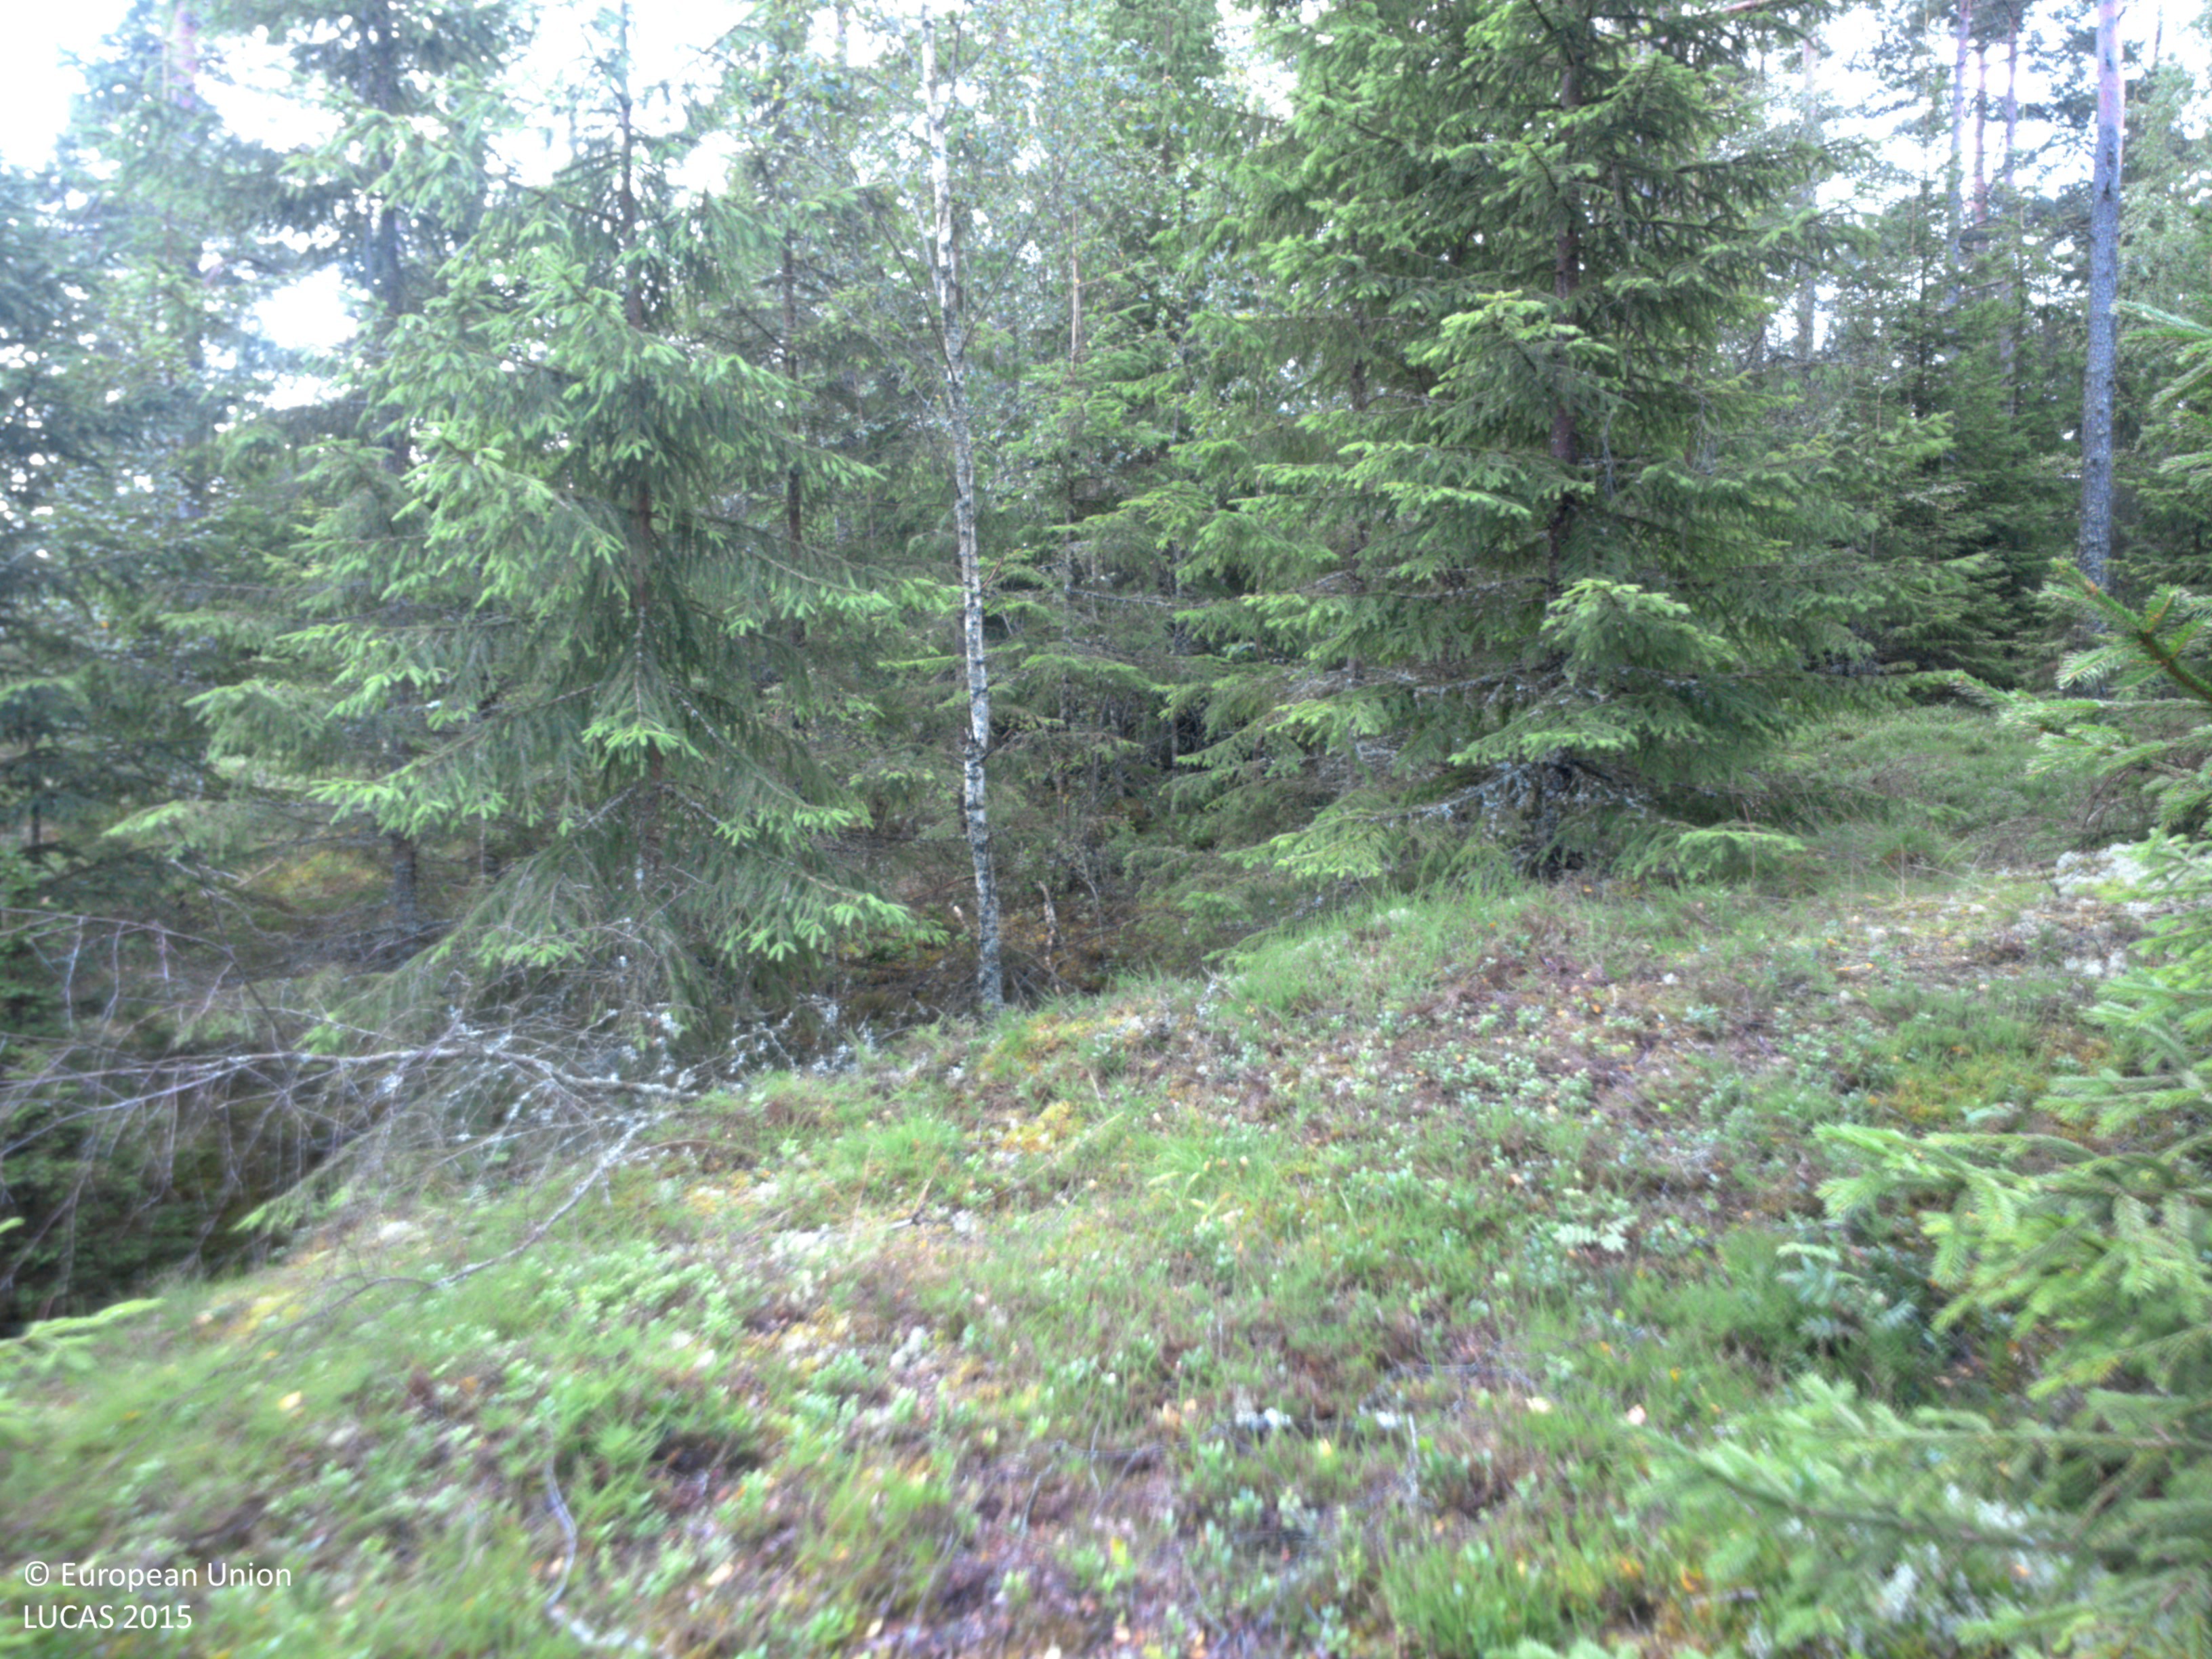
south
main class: Woodland
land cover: Spruce dominated mixed woodland
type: boreal forest
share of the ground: 50 - 75 %
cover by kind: coniferous forest trees 40 %, herbaceous plants 30 %, broadleaved forest trees 20 %, lichens and mosses 10 %
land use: Forestry
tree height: > 5 m
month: July
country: SE
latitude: 58.6373
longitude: 11.9424
